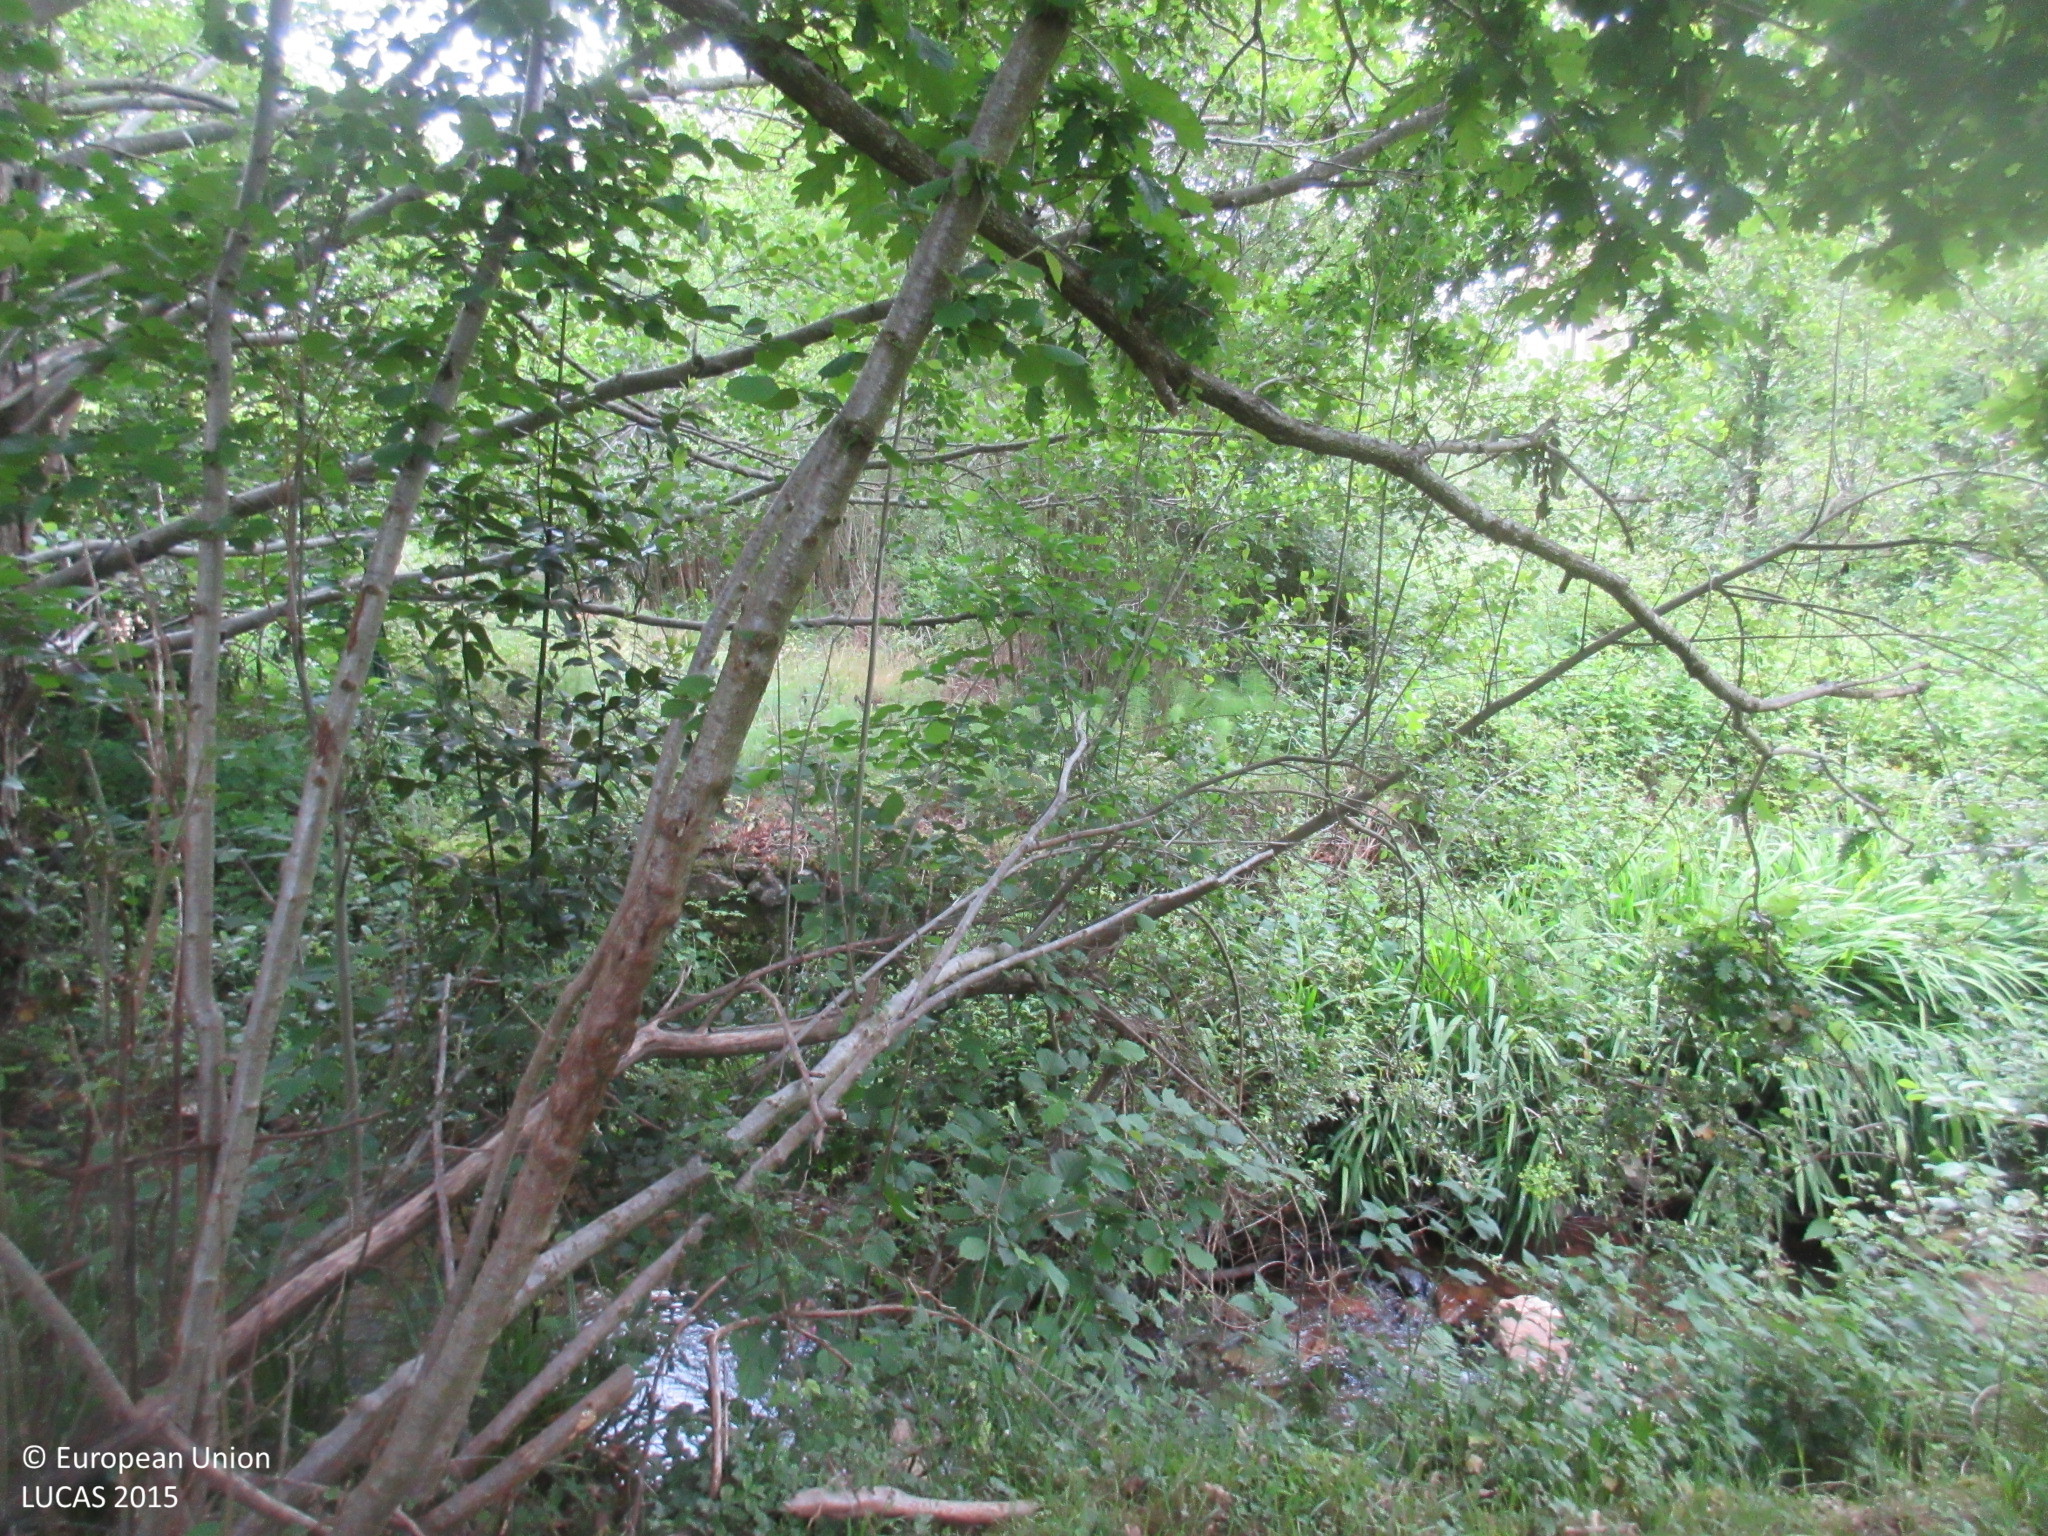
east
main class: Shrubland
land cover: Shrubland with sparse tree cover
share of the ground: 50 - 75 %
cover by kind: shrubs 65 %, herbaceous plants 30 %, broadleaved forest trees 5 %
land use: Agriculture (excluding fallow land and kitchen gardens)
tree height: > 5 m
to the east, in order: Shrubland with sparse tree cover; Ditches and canals; Shrubland without tree cover; Electric lines; Temporary grasslands; Paved roads, cycling and walking lanes; Fences; Other bare soil; Grass margins; Managed hedges; Grassland without tree/shrub cover
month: May
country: ES
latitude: 43.2893
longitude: -4.2406
